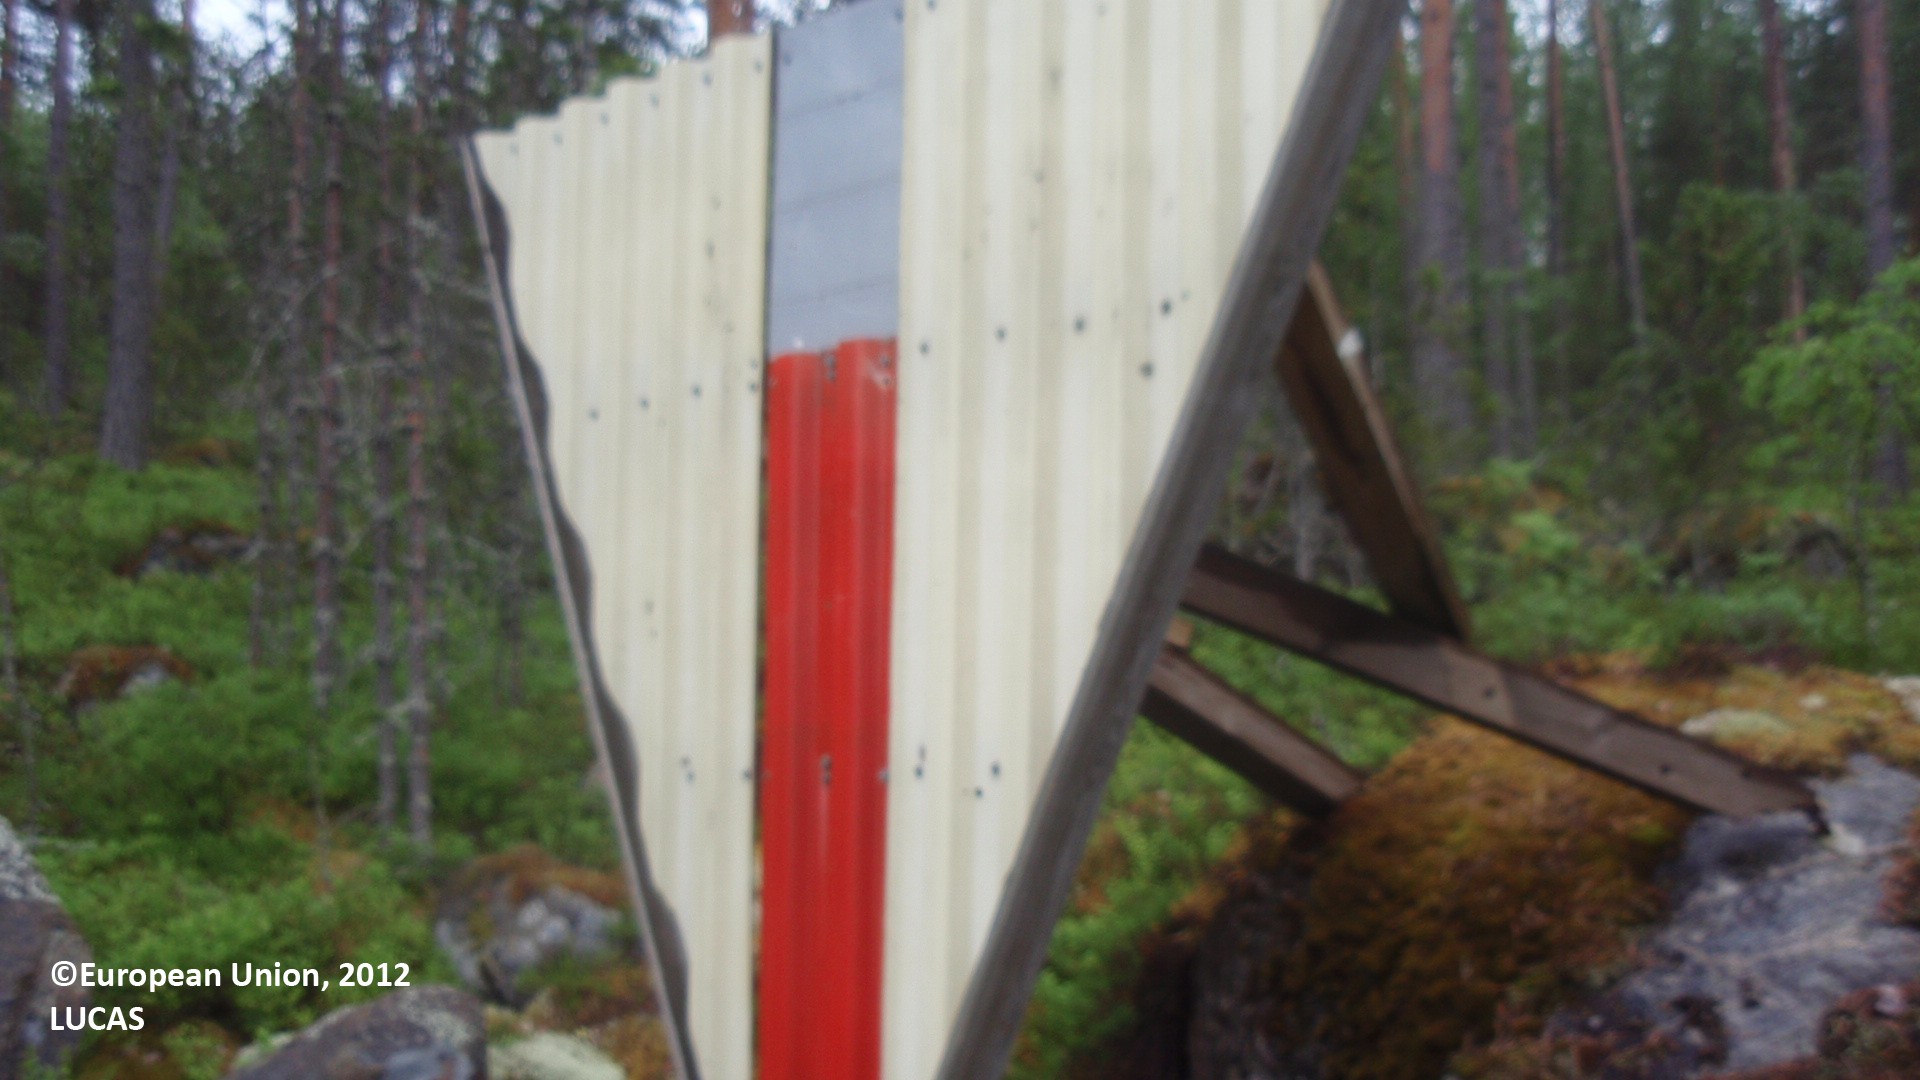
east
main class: Woodland
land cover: Pine dominated coniferous woodland
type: boreal forest
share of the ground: 25 - 50 %
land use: Forestry
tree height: > 5 m
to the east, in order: Pine dominated coniferous woodland; Rocks and stones; Pine dominated coniferous woodland; Lichens and moss; Pine dominated mixed woodland
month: July
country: FI
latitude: 61.5066
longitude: 28.3391
